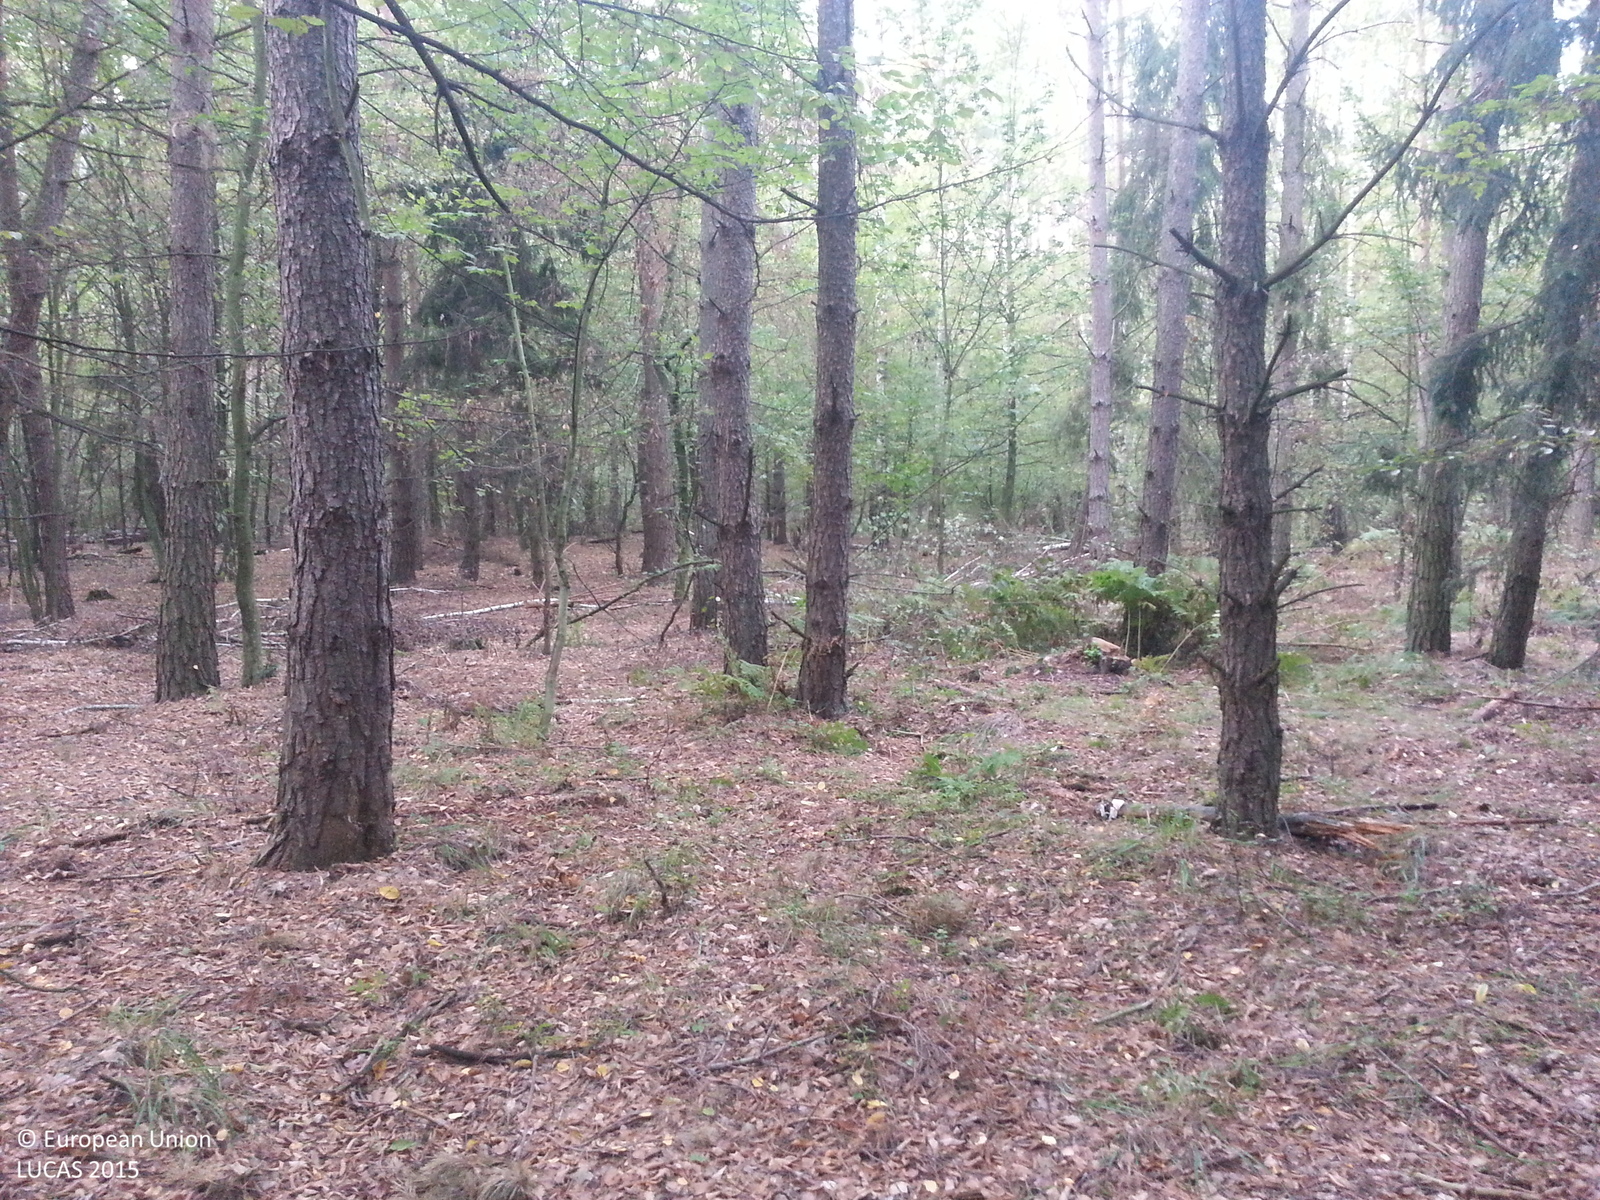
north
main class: Woodland
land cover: Other mixed woodland
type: hemiboreal forest and nemoral coniferous forest and mixed broadleaved-coniferous forest
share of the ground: > 75 %
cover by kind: broadleaved forest trees 45 %, coniferous forest trees 30 %, unconsolidated bare surface 20 %, herbaceous plants 5 %
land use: Forestry
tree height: > 5 m
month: September
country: PL
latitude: 53.1804
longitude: 19.1664
